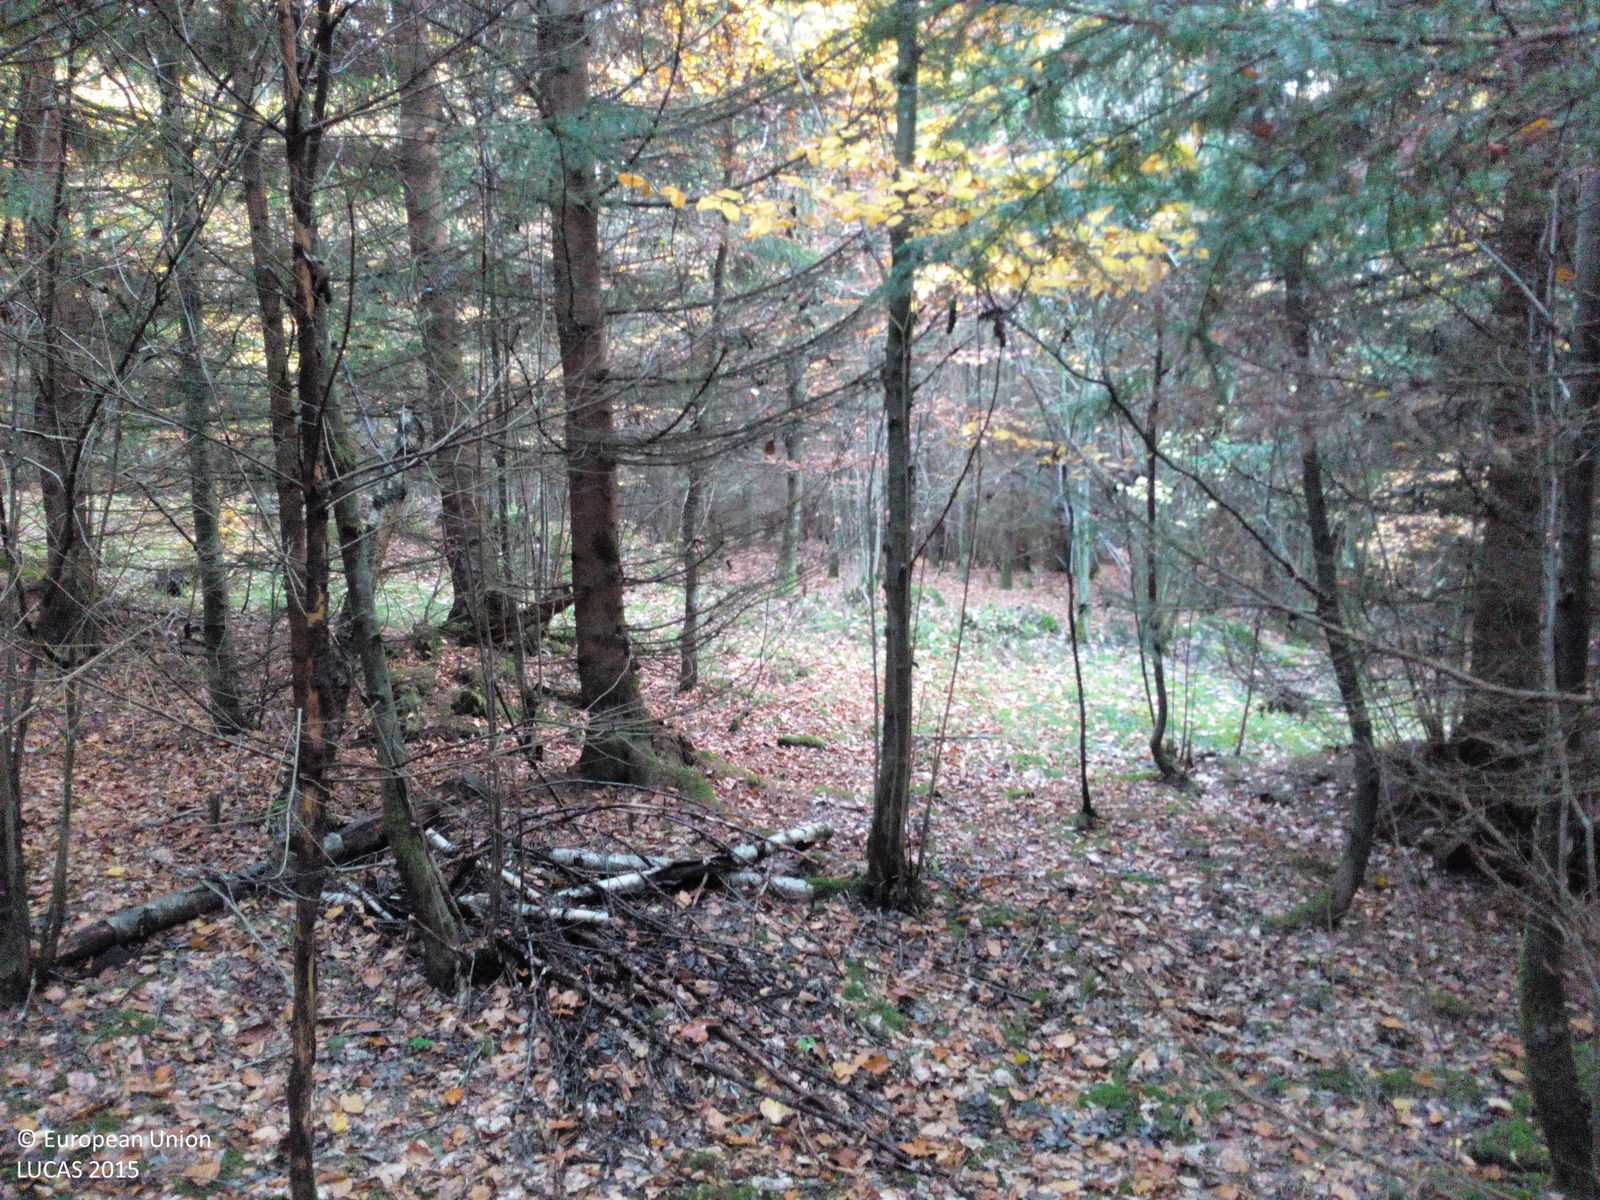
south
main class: Woodland
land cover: Spruce dominated mixed woodland
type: hemiboreal forest and nemoral coniferous forest and mixed broadleaved-coniferous forest
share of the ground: > 75 %
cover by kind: coniferous forest trees 45 %, broadleaved forest trees 30 %, lichens and mosses 15 %, unconsolidated bare surface 10 %
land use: Forestry
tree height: > 5 m
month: October
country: DE
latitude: 50.3280
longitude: 9.9017
